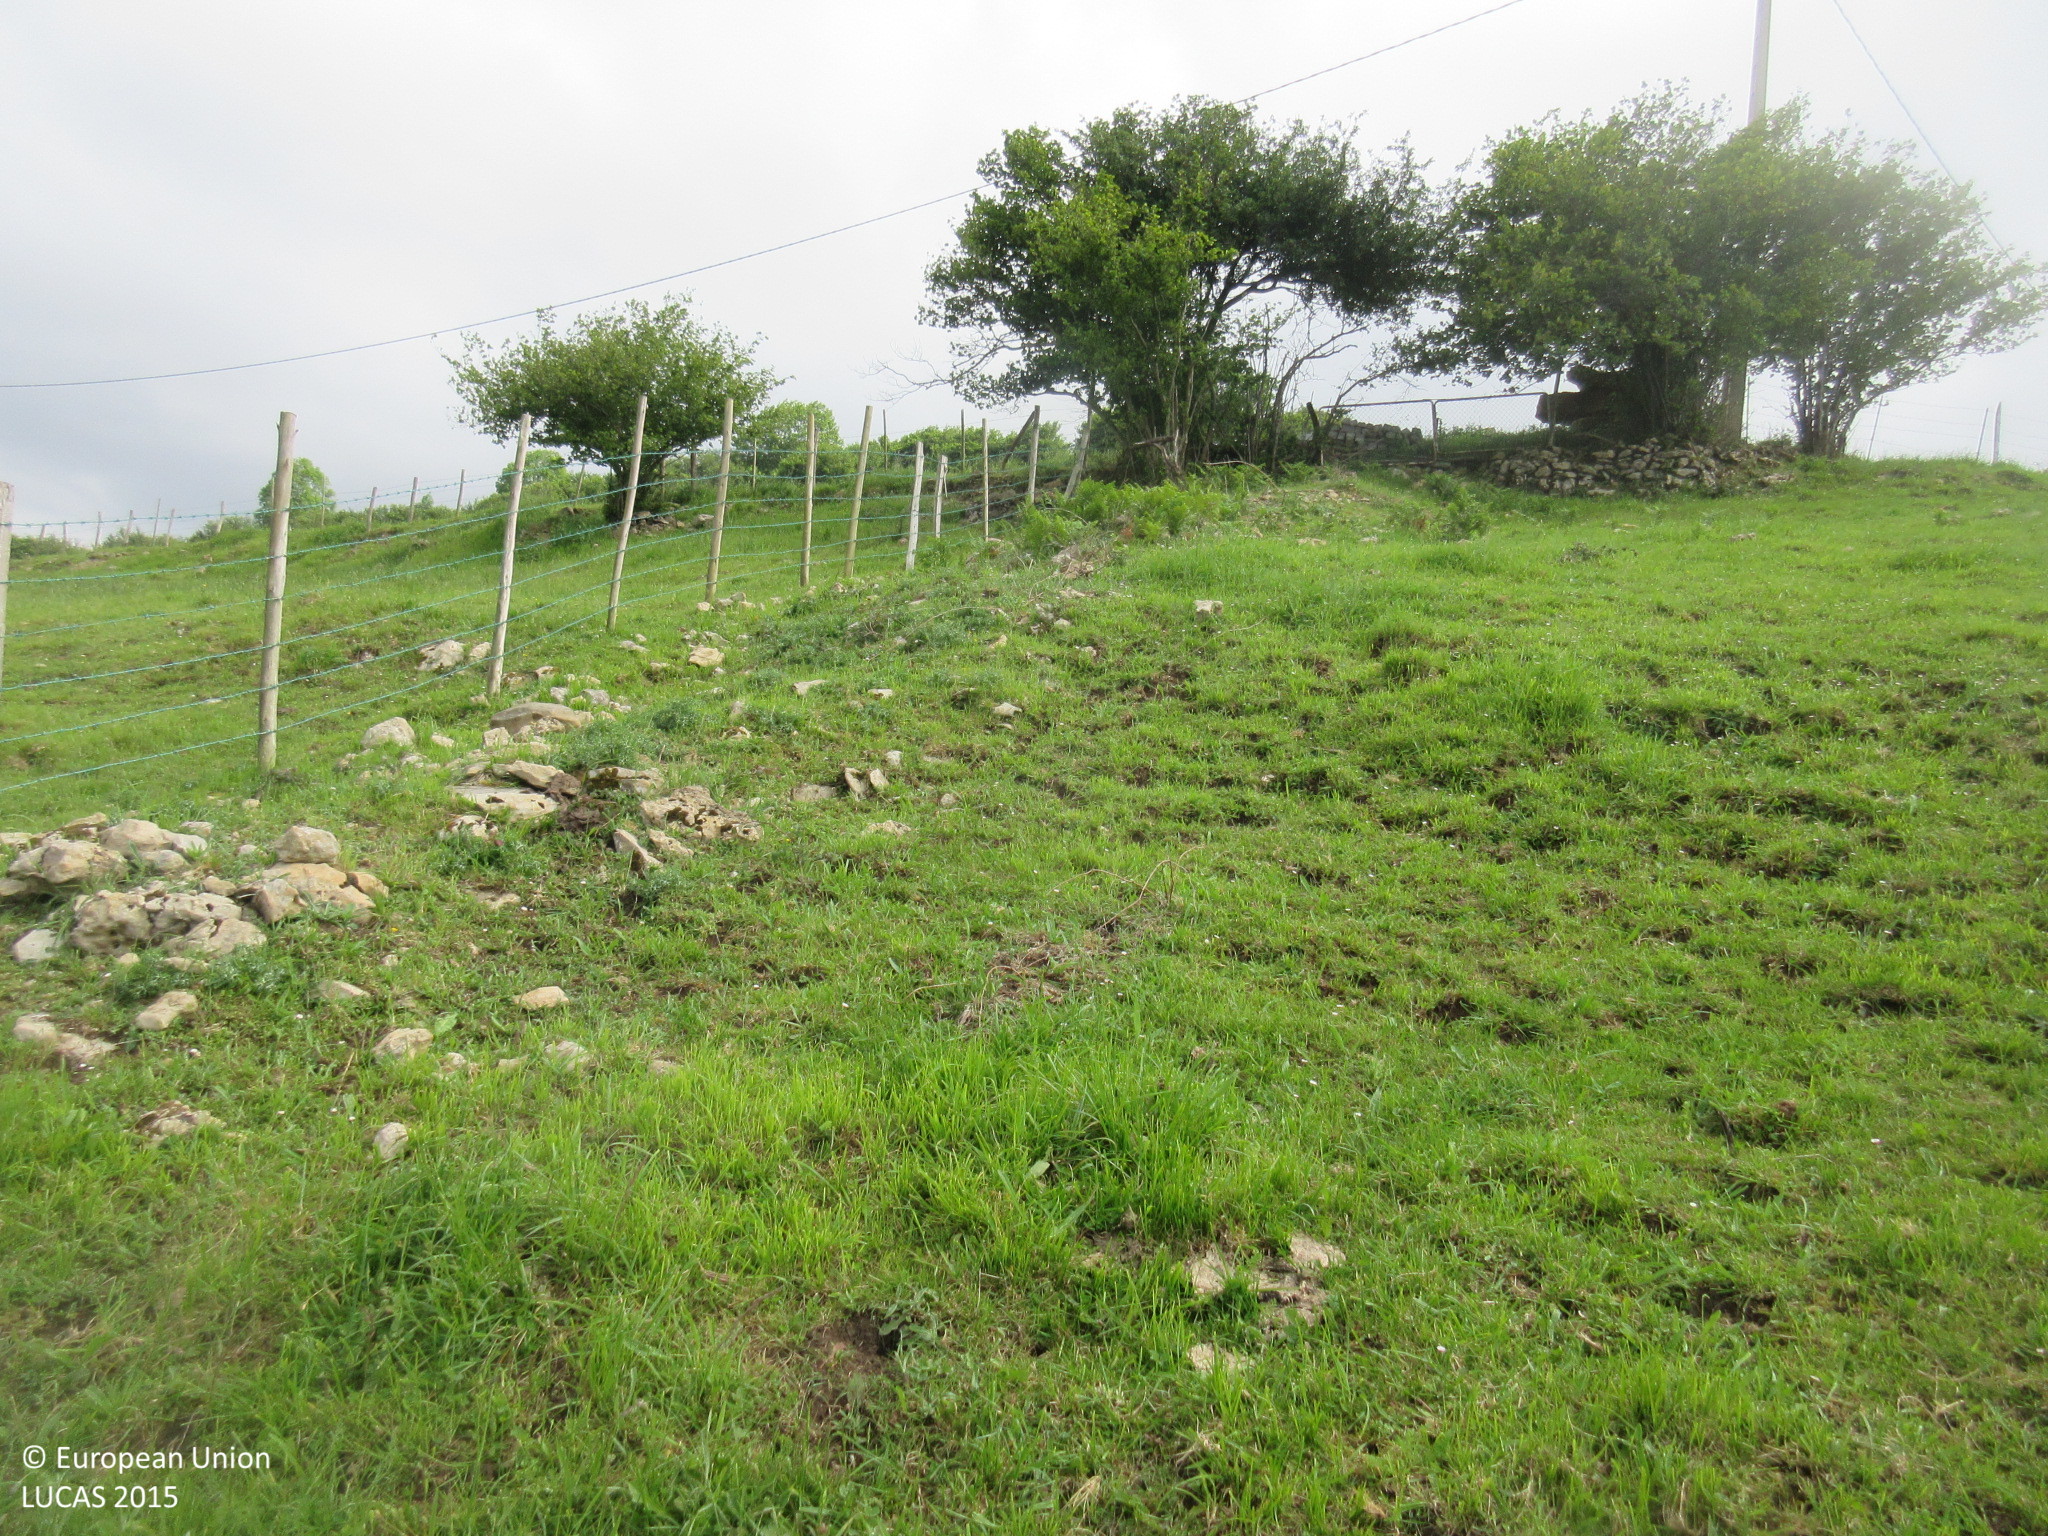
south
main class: Grassland
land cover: Grassland without tree/shrub cover
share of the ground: > 75 %
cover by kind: herbaceous plants 100 %
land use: Agriculture (excluding fallow land and kitchen gardens)
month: May
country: ES
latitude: 43.3187
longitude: -4.5492
